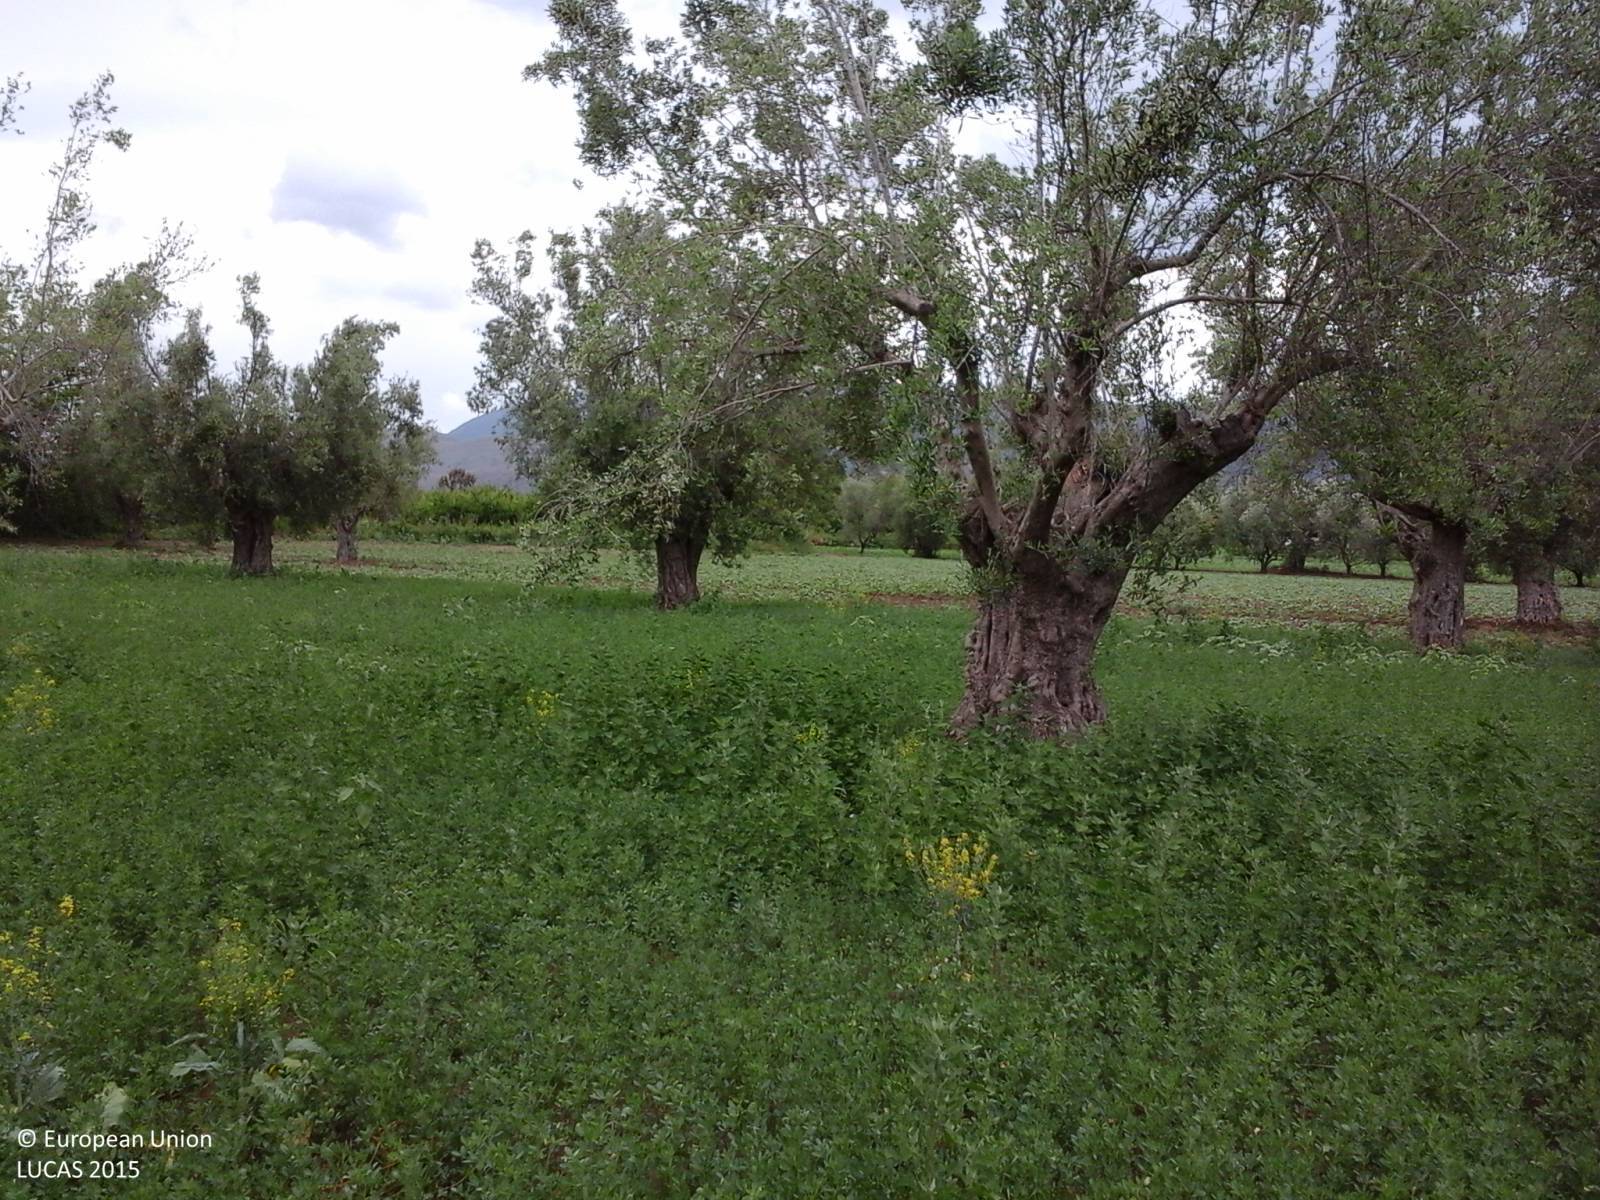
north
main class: Cropland
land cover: Lucerne
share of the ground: > 75 %
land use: Agriculture (excluding fallow land and kitchen gardens)
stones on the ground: < 10 %
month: May
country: IT
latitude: 41.1560
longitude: 14.1900
